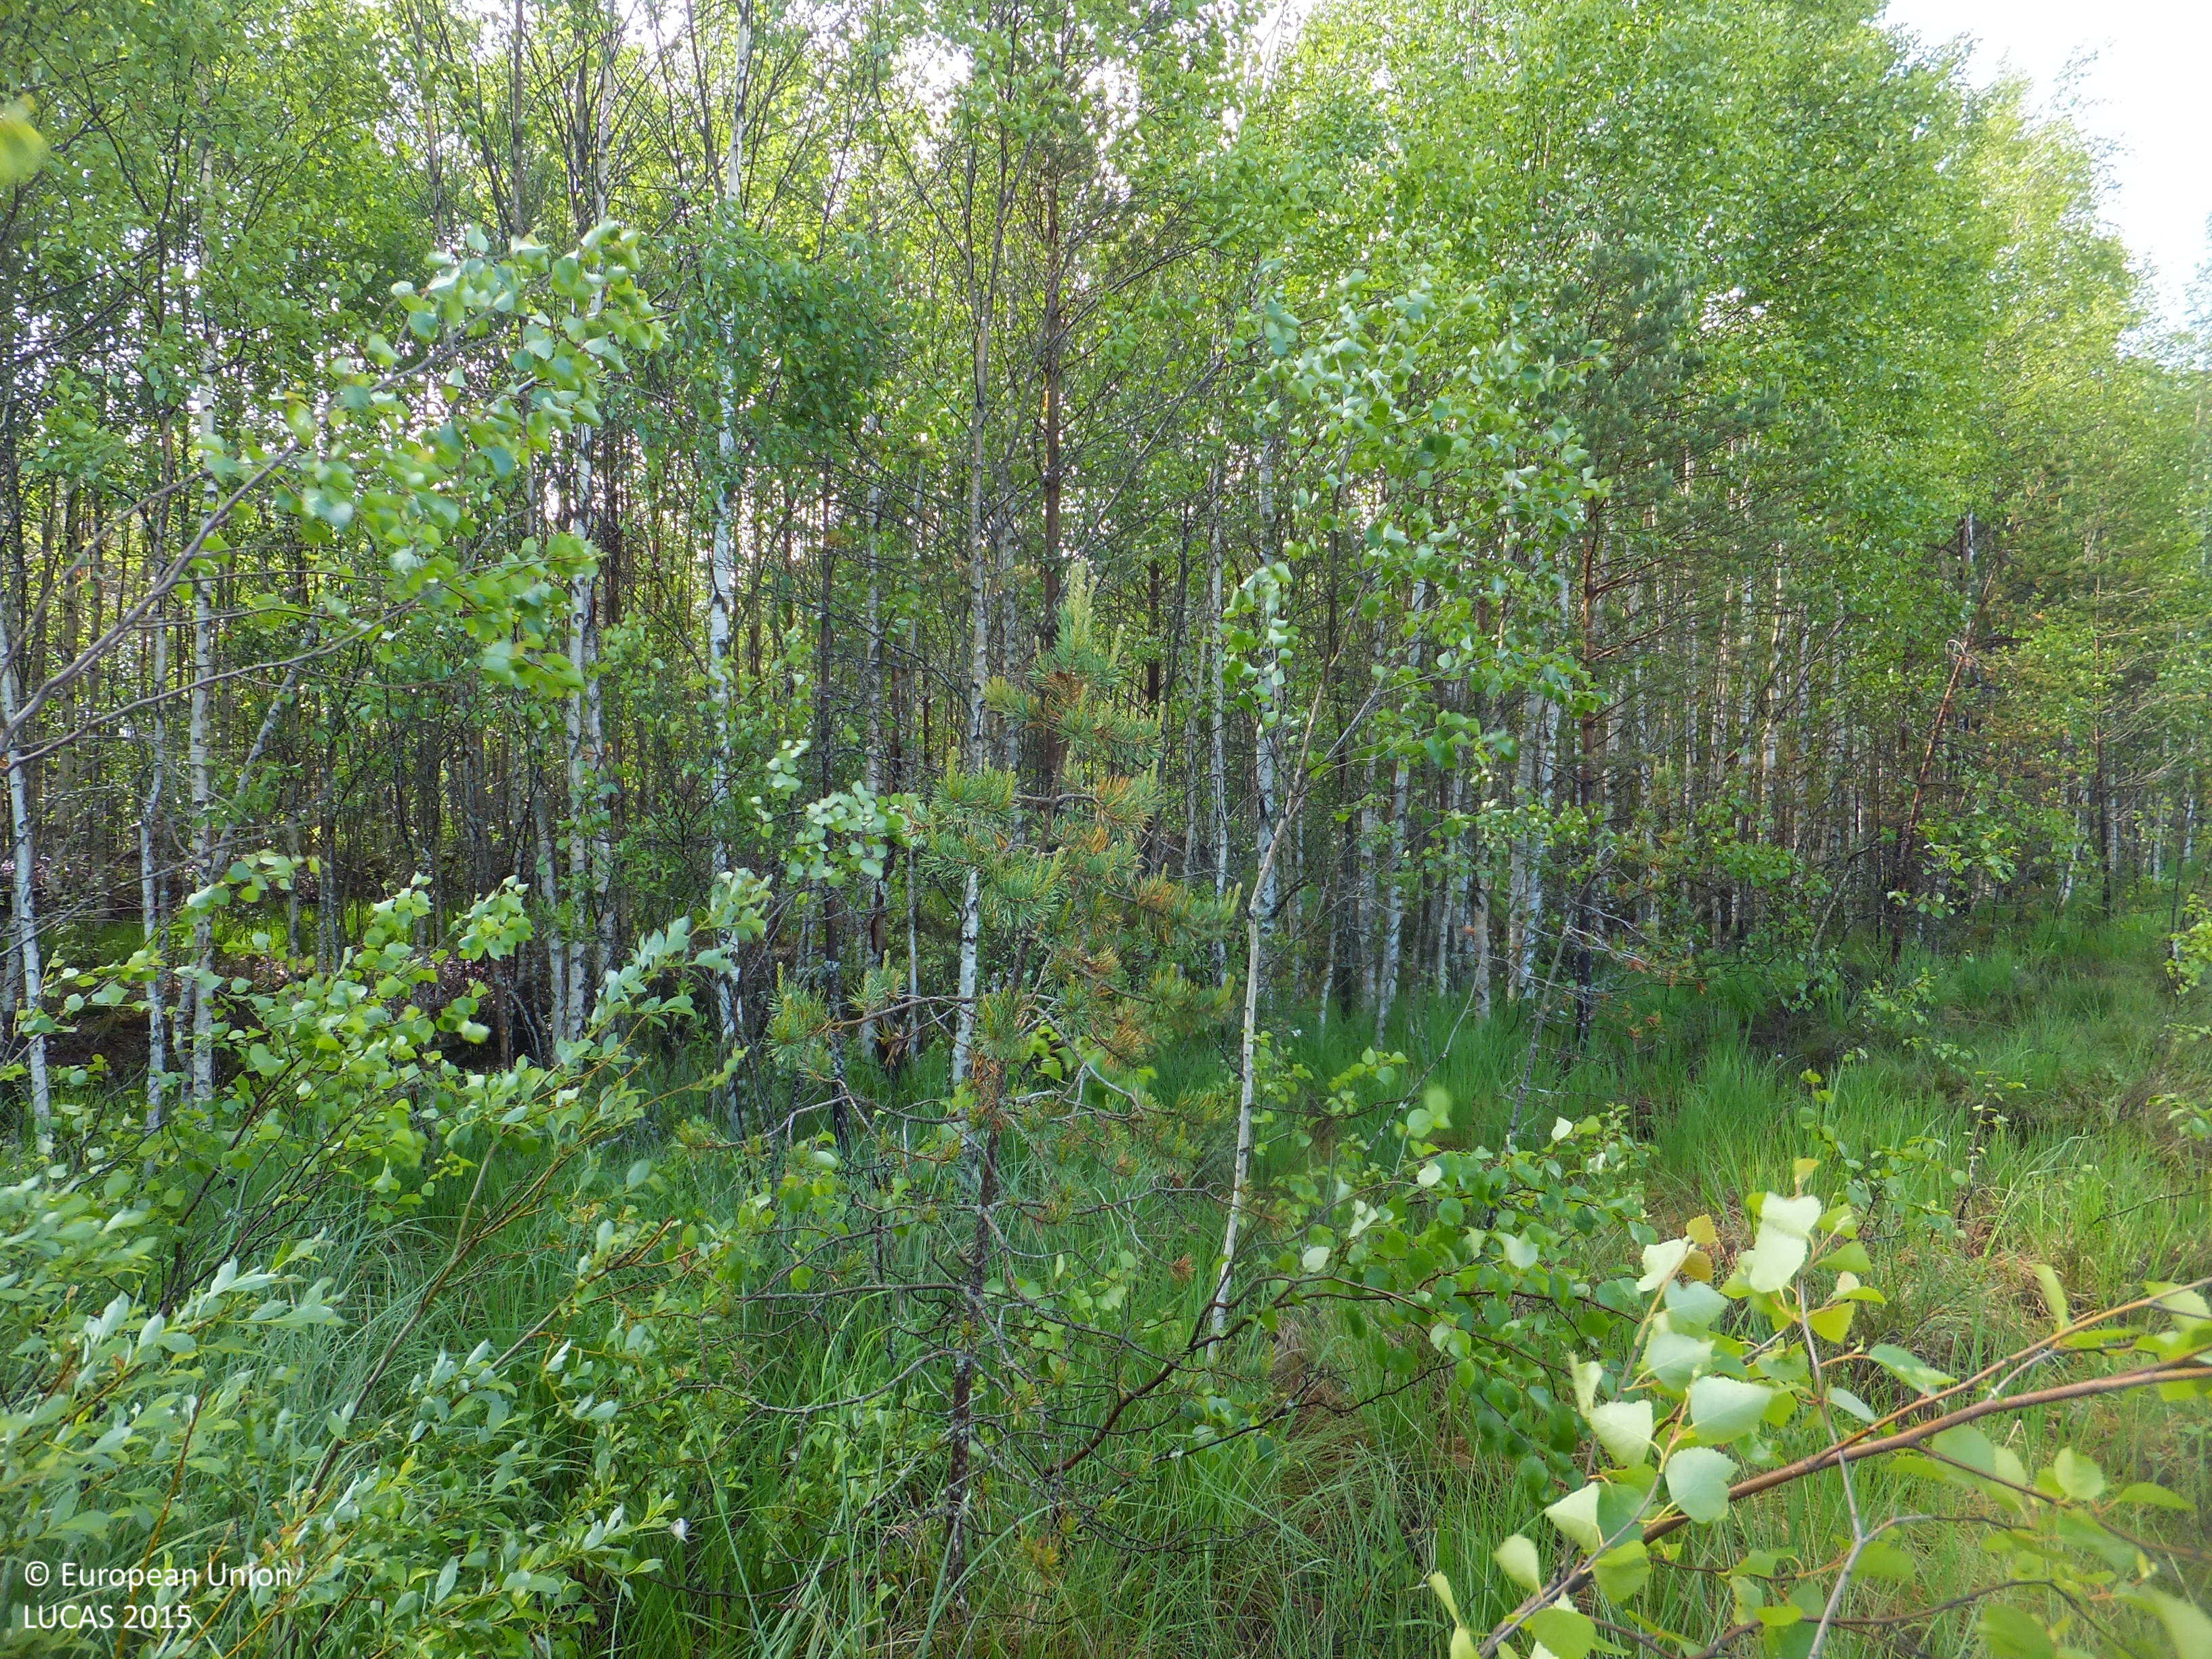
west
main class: Woodland
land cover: Broadleaved woodland
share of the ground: 25 - 50 %
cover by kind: broadleaved forest trees 30 %, herbaceous plants 30 %, shrubs 20 %, lichens and mosses 10 %
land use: Semi-natural and natural areas not in use
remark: Temporary flooded
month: June
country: FI
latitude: 63.4325
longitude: 24.6941
